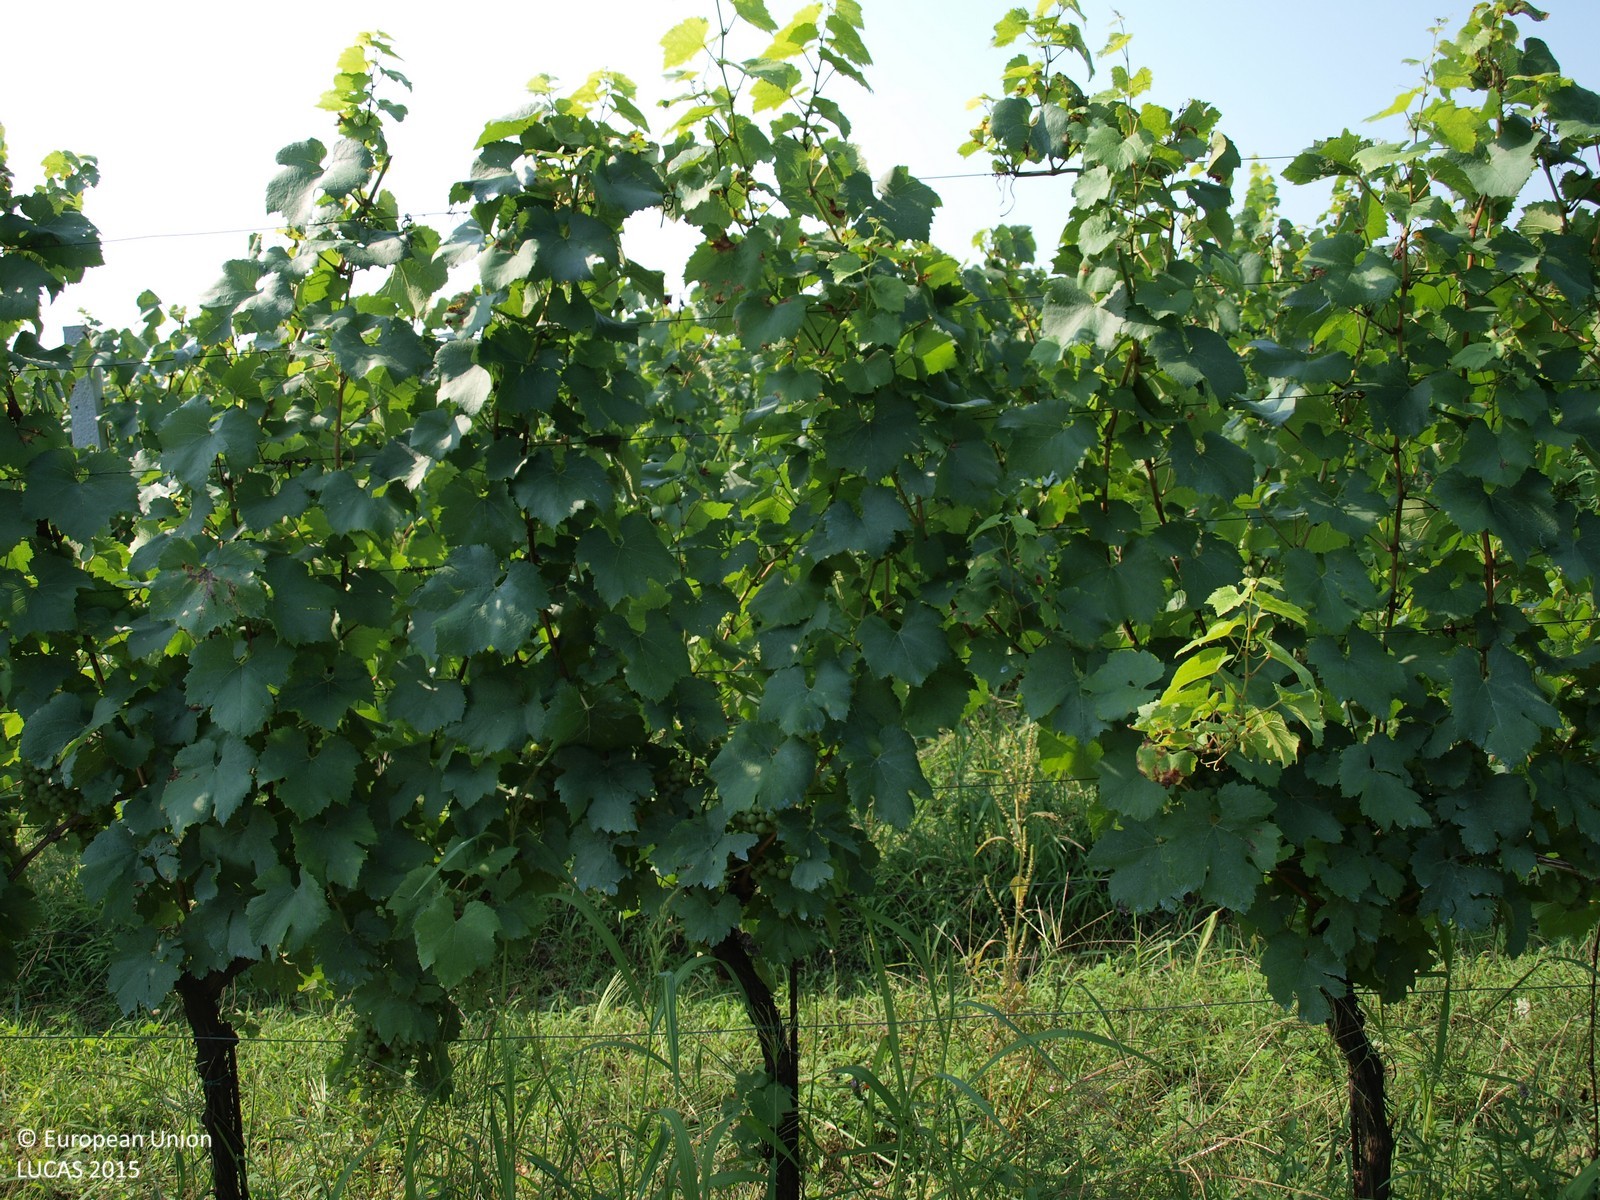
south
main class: Cropland
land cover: Vineyards
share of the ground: 50 - 75 %
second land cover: Grassland without tree/shrub cover
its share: 50 - 75 %
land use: Agriculture (excluding fallow land and kitchen gardens)
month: August
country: HR
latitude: 45.9241
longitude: 16.4080
